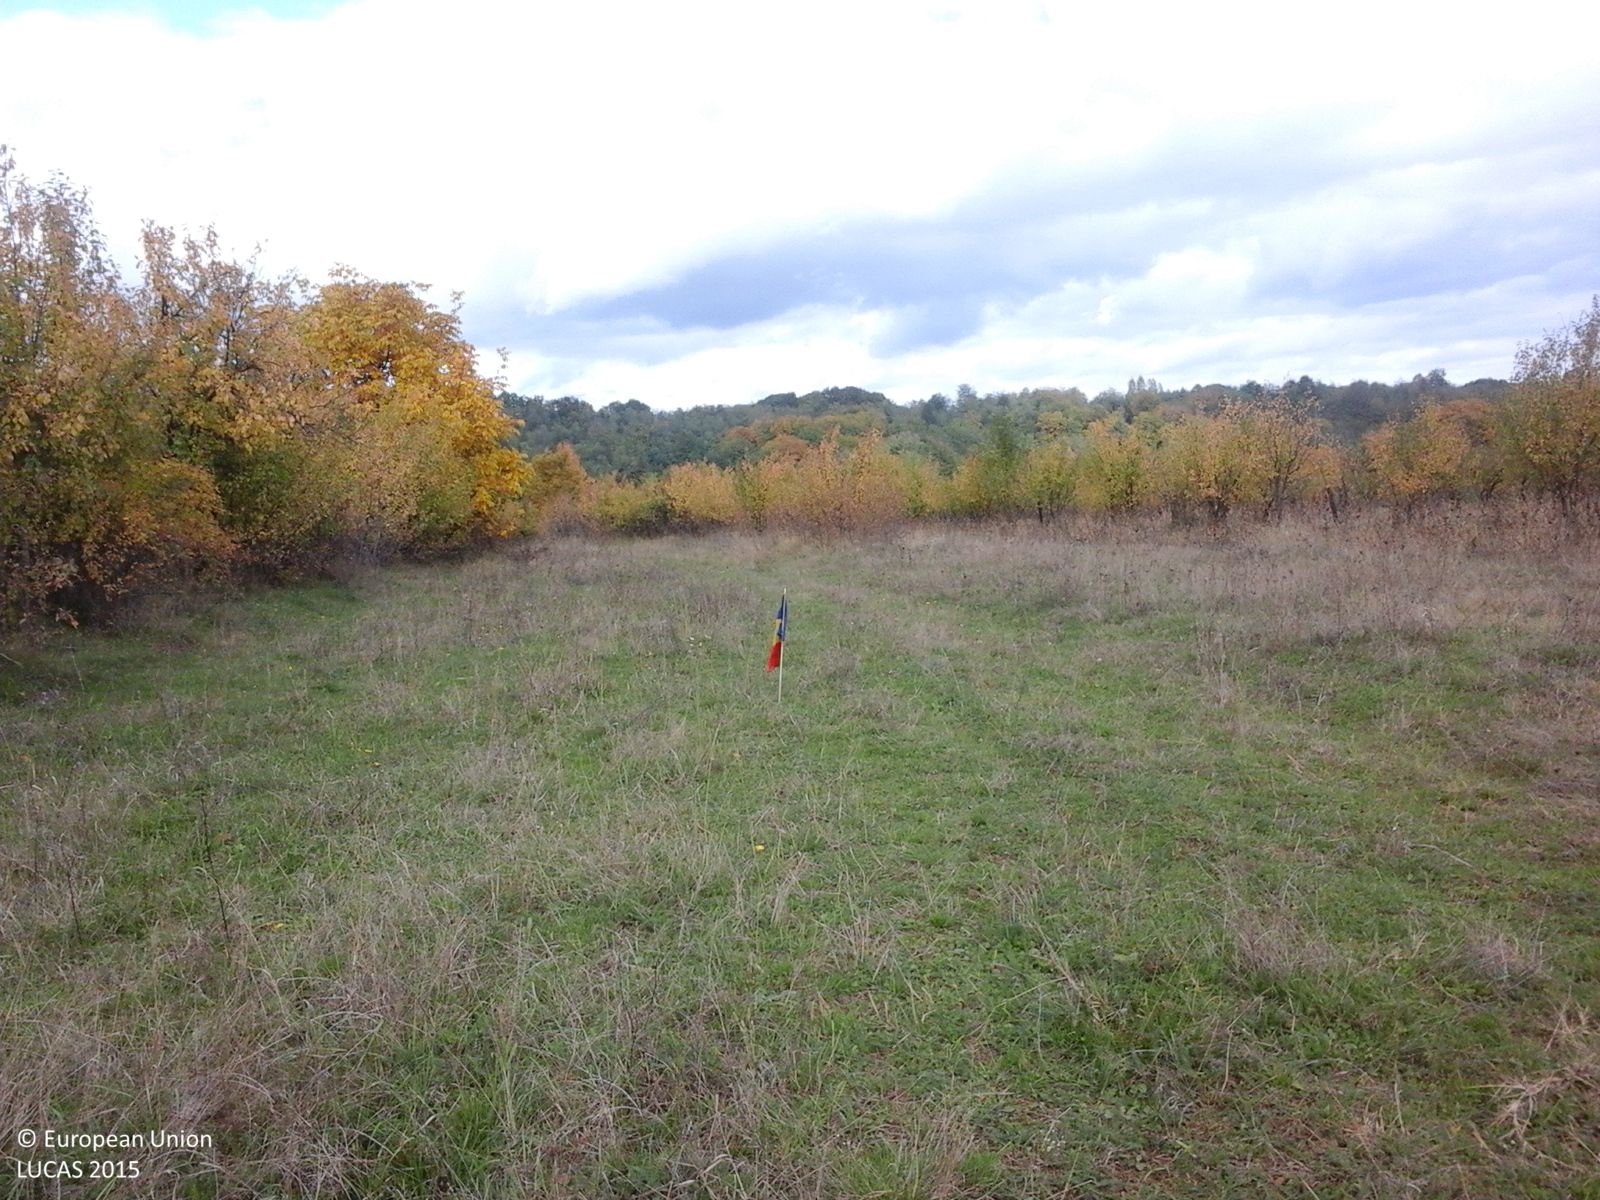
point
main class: Grassland
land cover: Grassland without tree/shrub cover
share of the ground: > 75 %
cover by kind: herbaceous plants 100 %
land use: Agriculture (excluding fallow land and kitchen gardens)
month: October
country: RO
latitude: 45.0946
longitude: 25.7971
